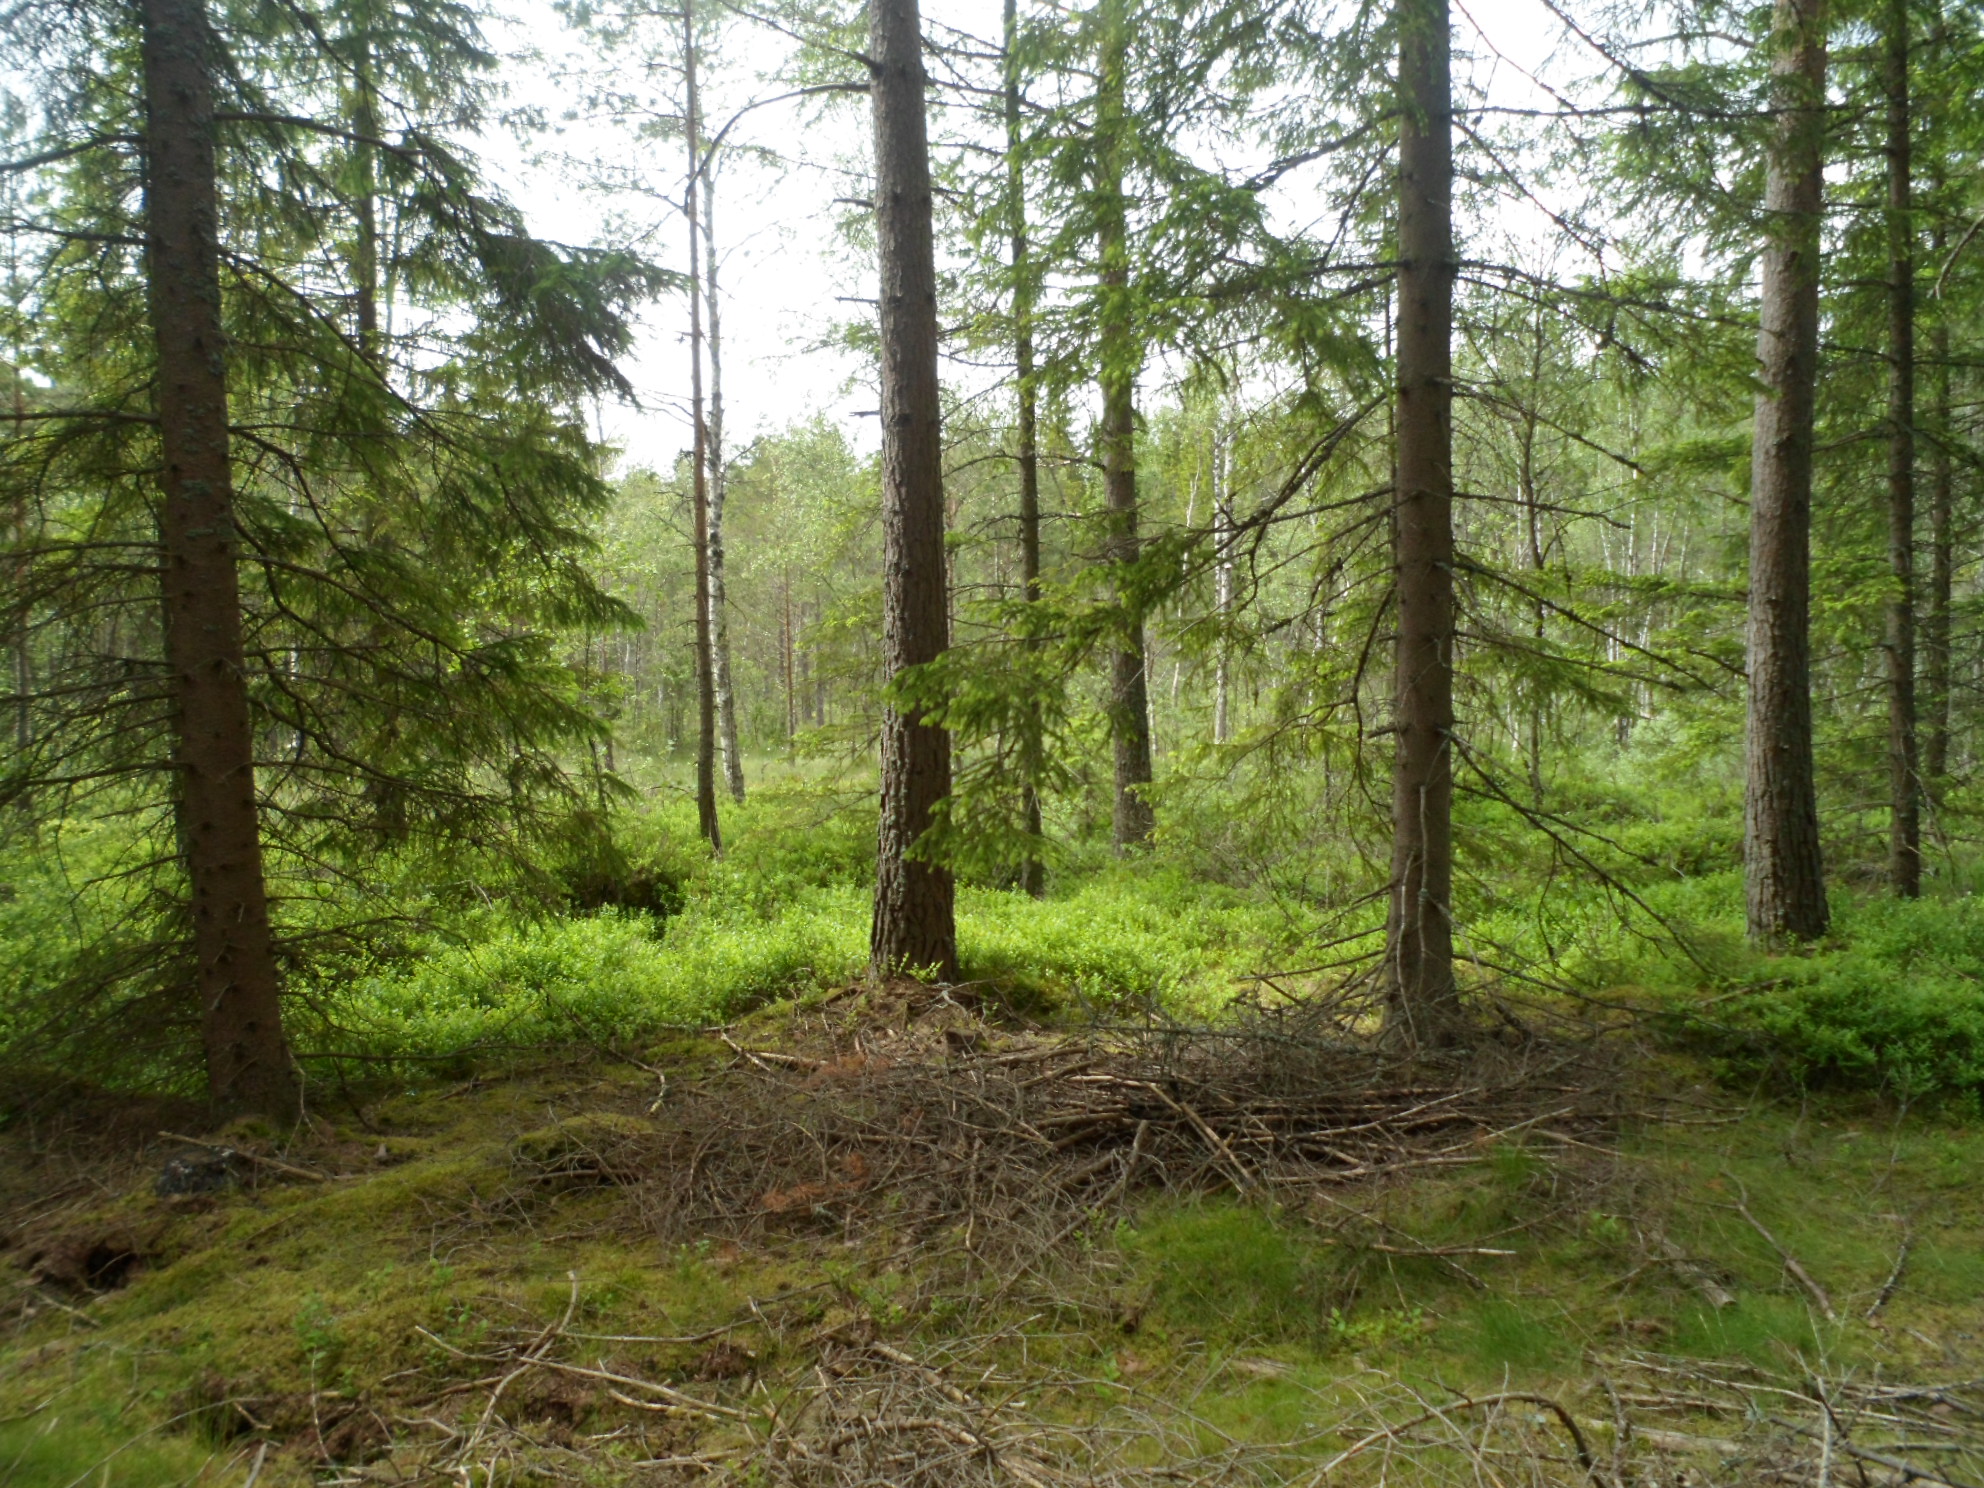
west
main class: Woodland
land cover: Spruce dominated coniferous woodland
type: boreal forest
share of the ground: 50 - 75 %
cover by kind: coniferous forest trees 50 %, lichens and mosses 30 %, shrubs 10 %, herbaceous plants 10 %
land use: Forestry
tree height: > 5 m
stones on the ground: 10 - 25 %
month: June
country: SE
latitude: 56.9377
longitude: 15.4380
